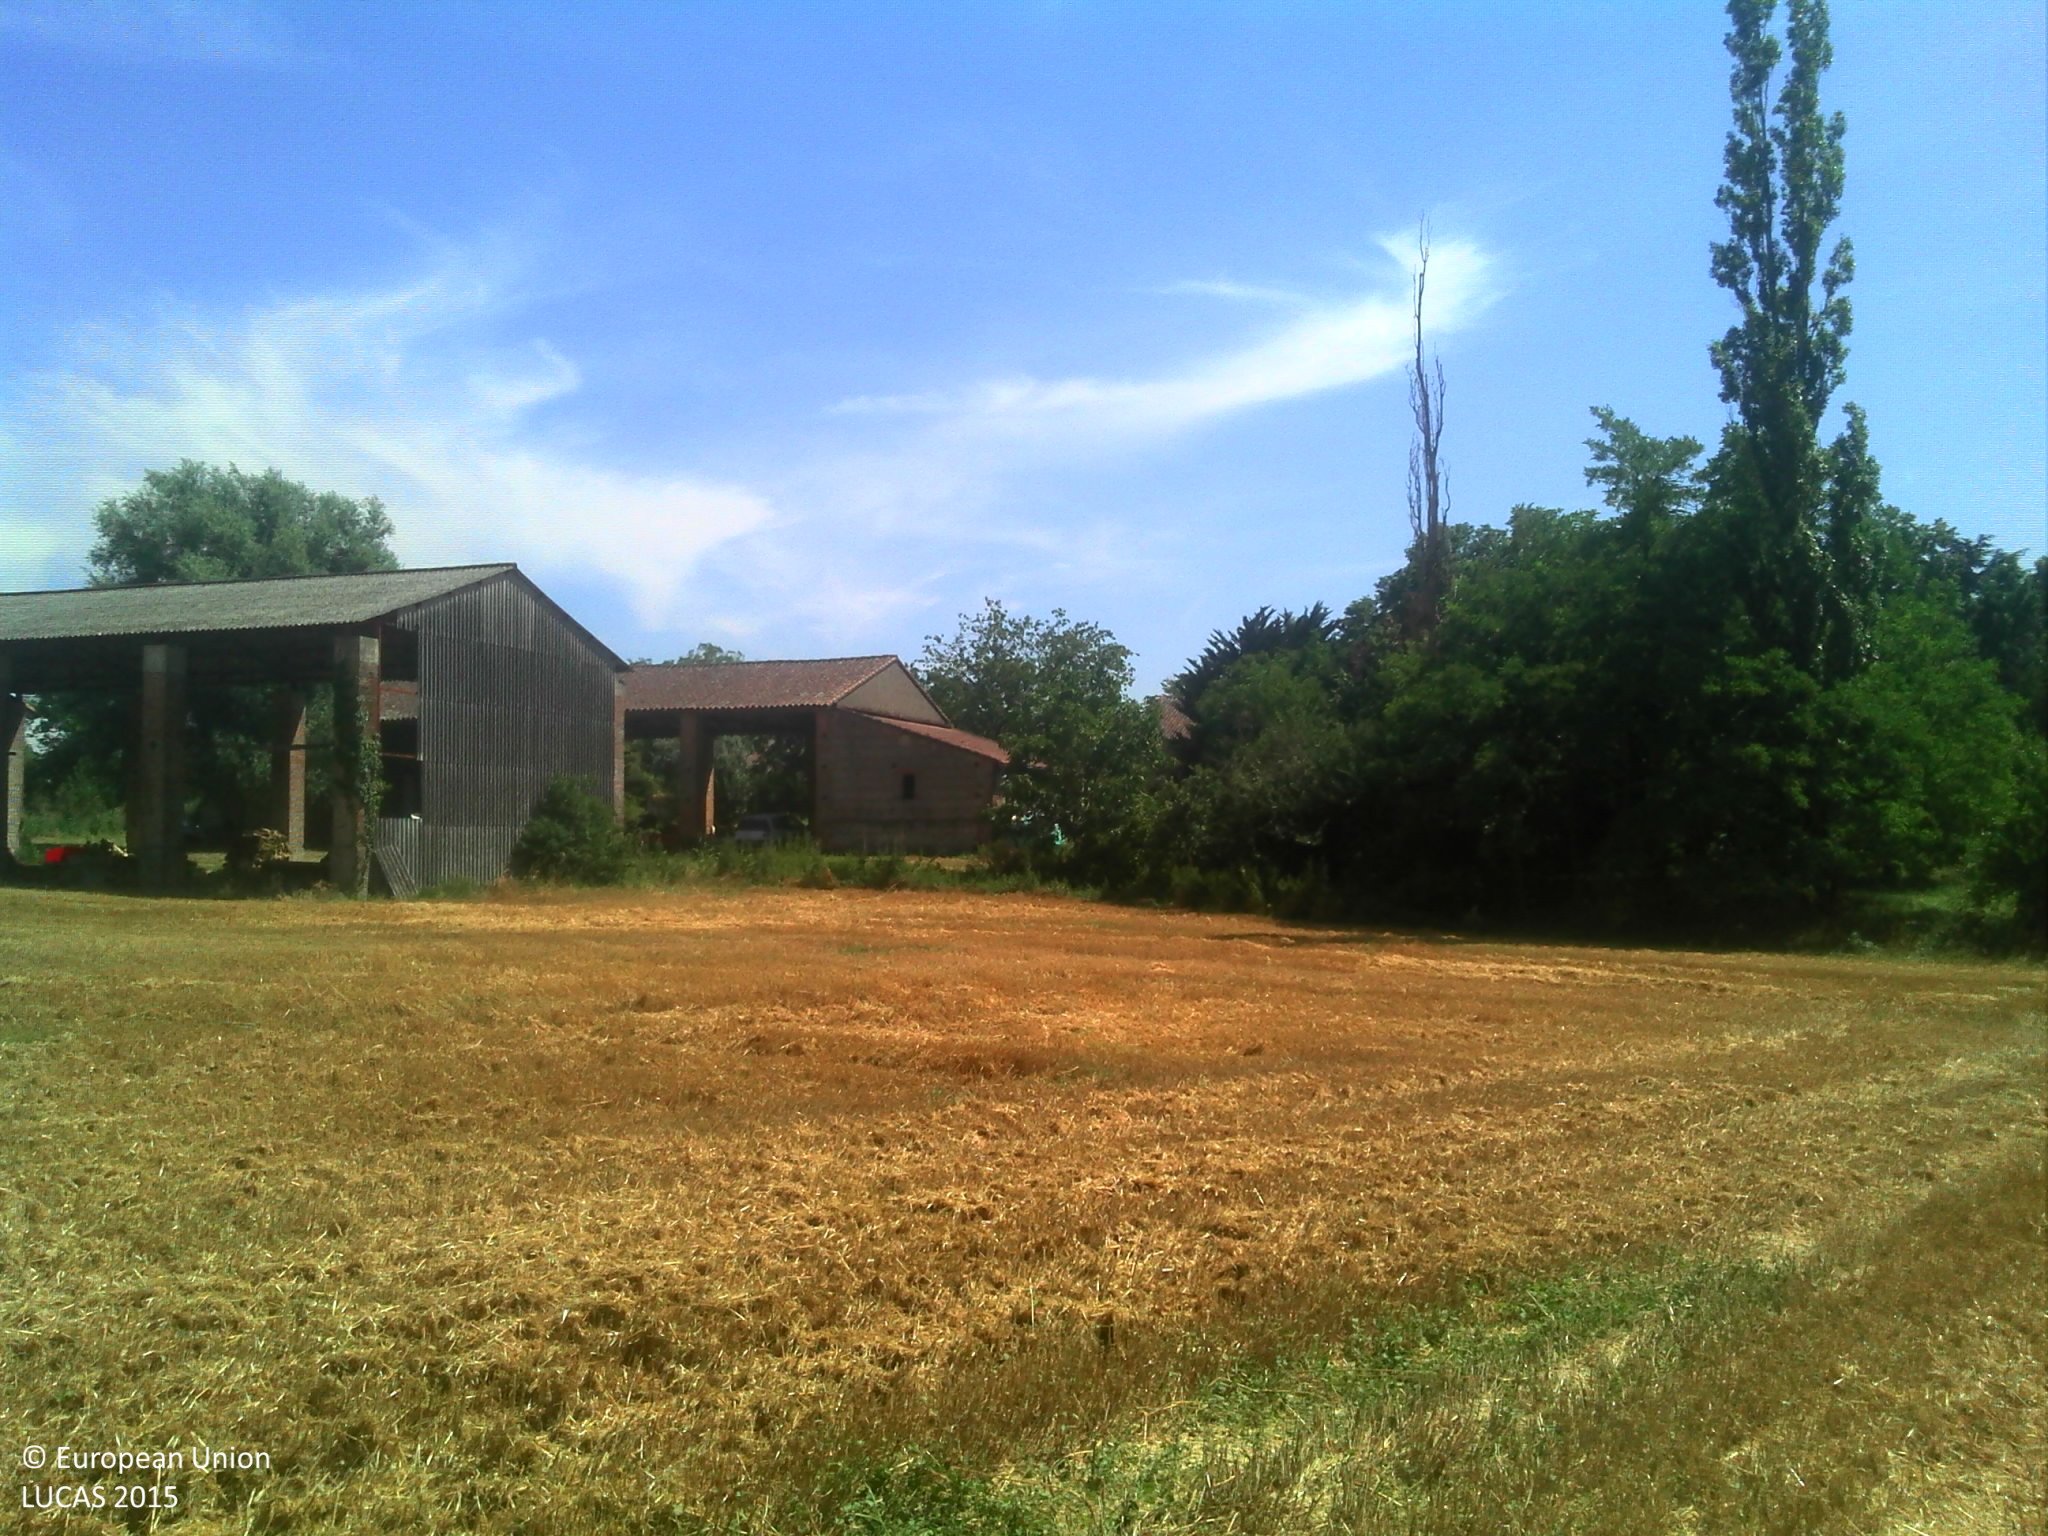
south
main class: Cropland
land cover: Durum wheat
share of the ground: > 75 %
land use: Agriculture (excluding fallow land and kitchen gardens)
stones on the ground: < 10 %
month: July
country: FR
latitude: 43.5061
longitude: 1.4316
